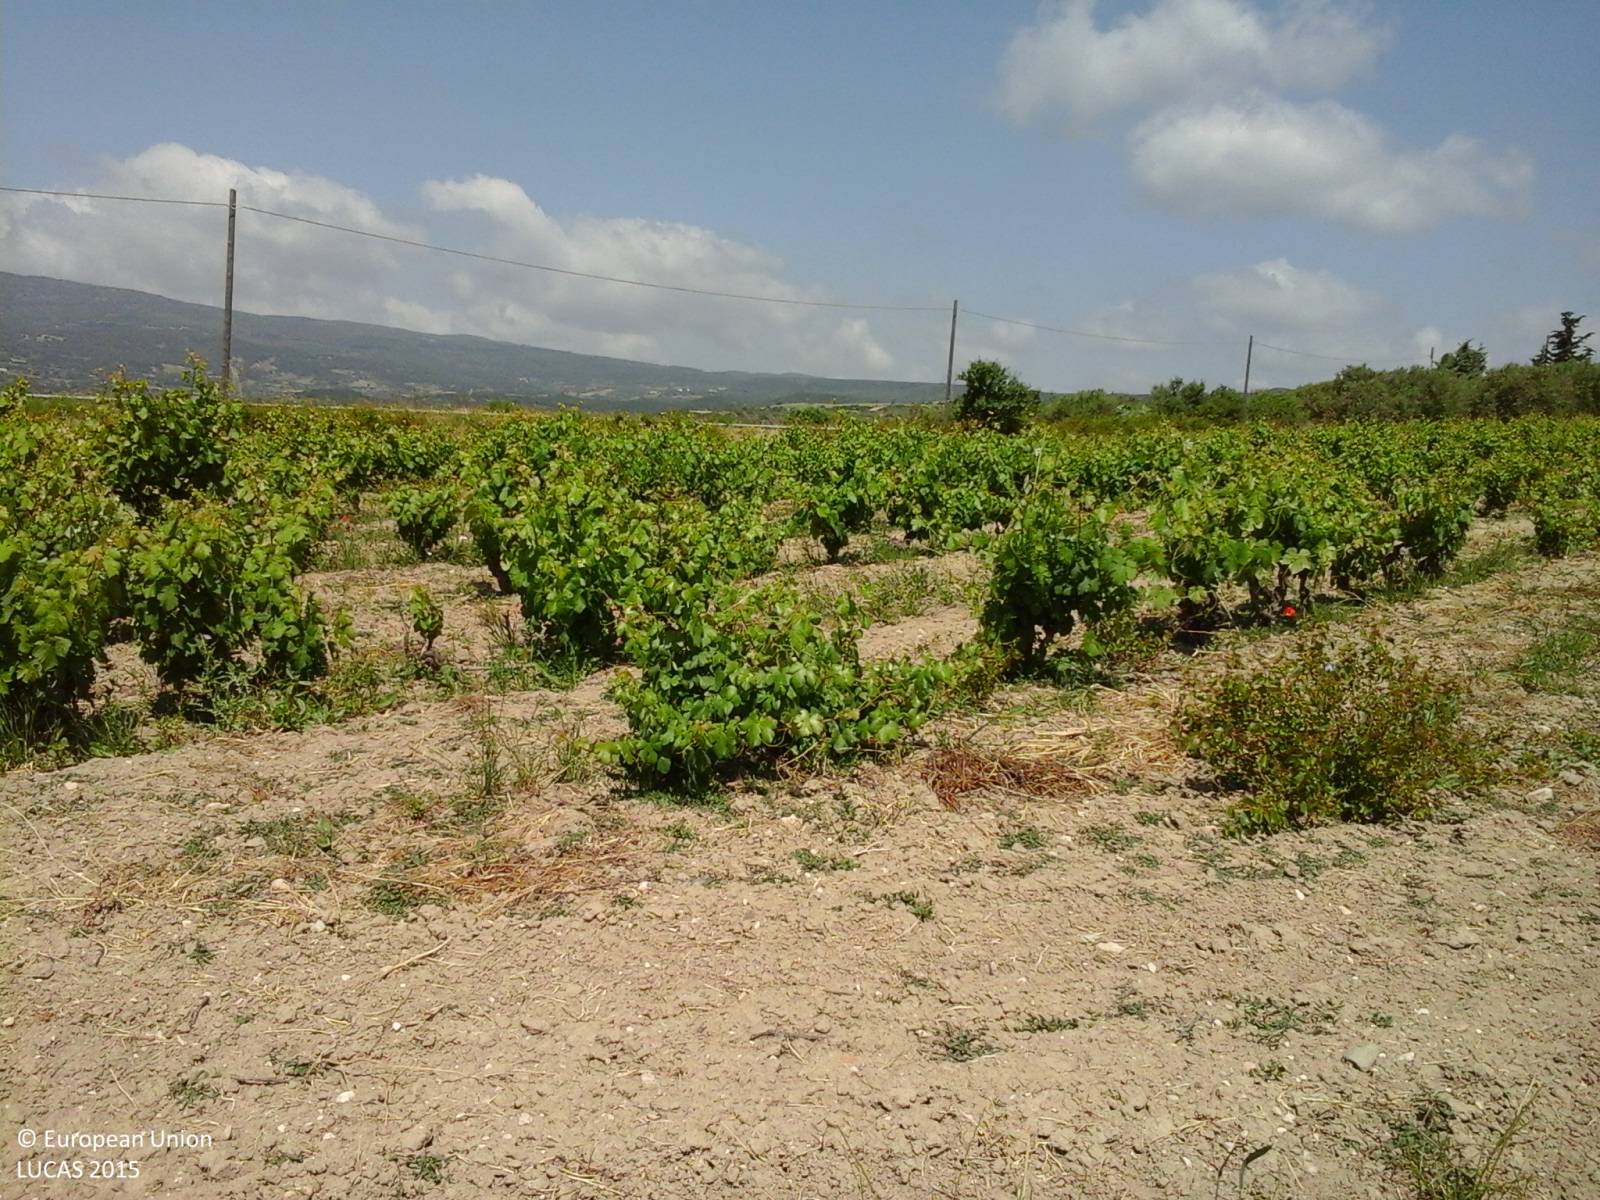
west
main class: Cropland
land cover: Temporary grasslands
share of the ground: > 75 %
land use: Agriculture (excluding fallow land and kitchen gardens)
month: May
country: IT
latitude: 39.7898
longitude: 8.8504
